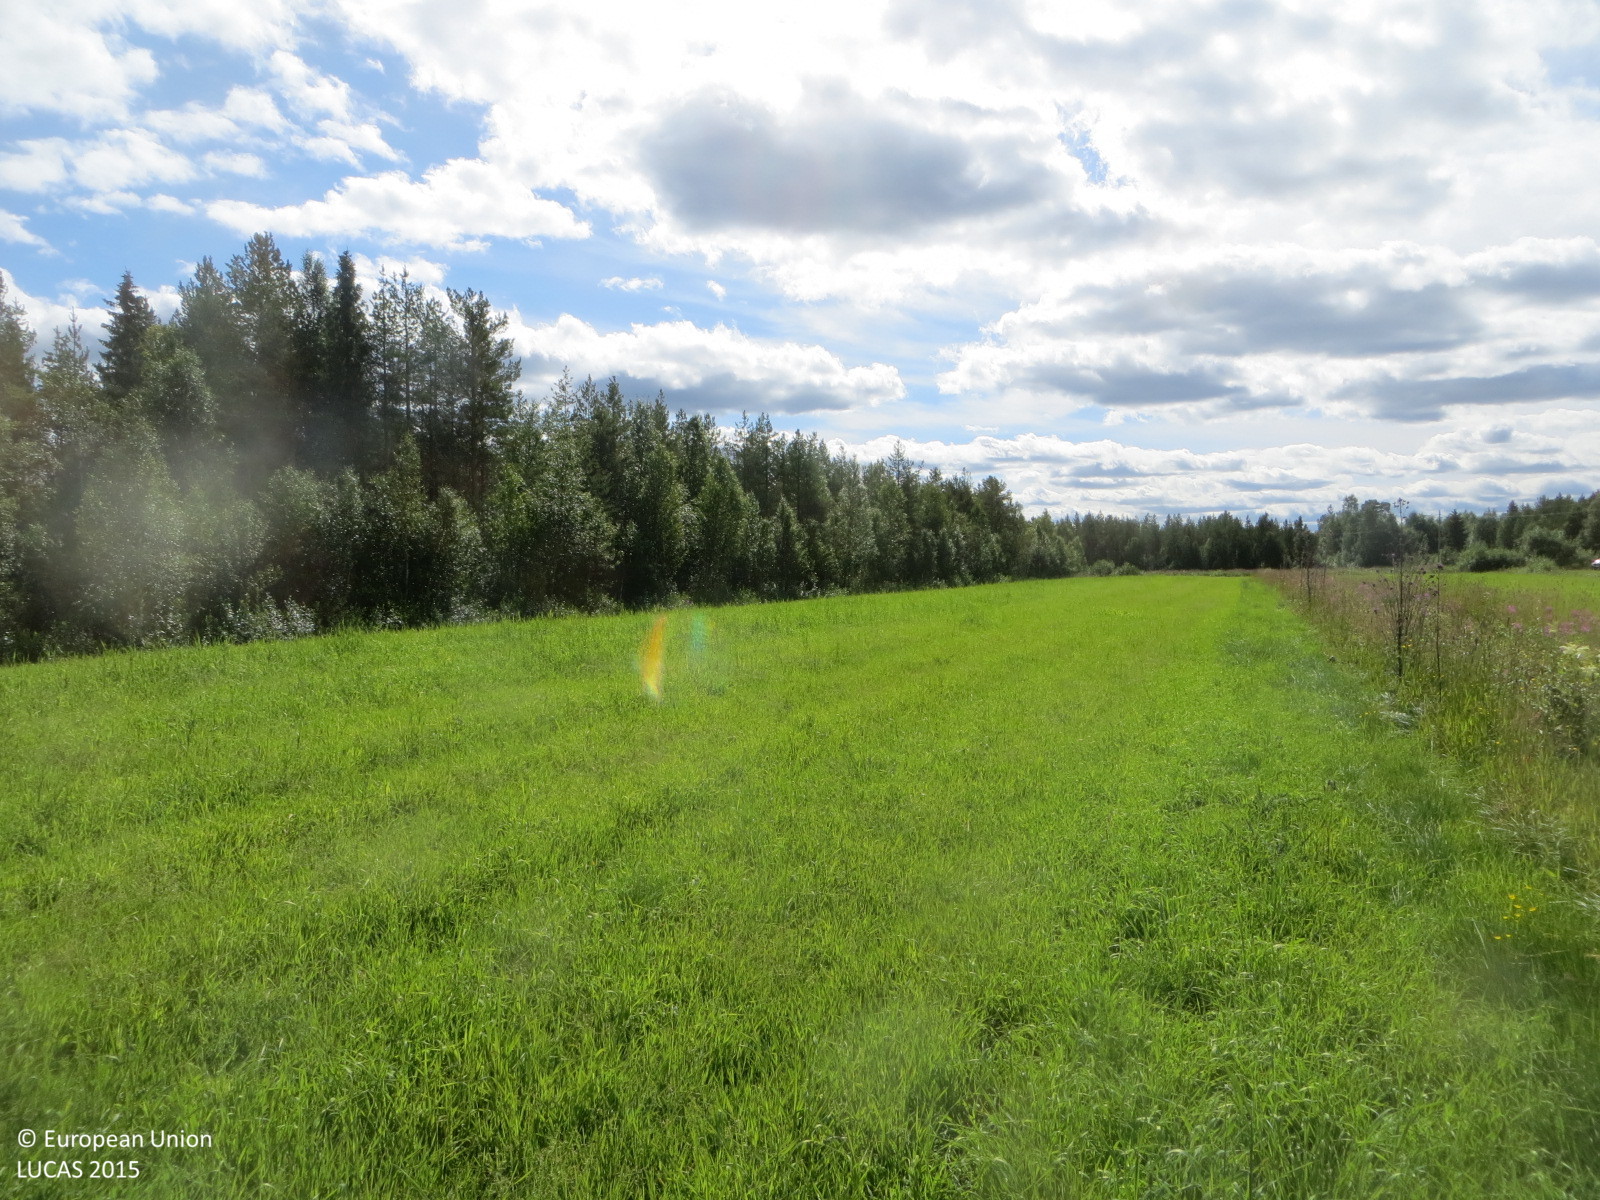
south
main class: Grassland
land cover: Grassland without tree/shrub cover
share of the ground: > 75 %
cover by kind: herbaceous plants 100 %
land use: Agriculture (excluding fallow land and kitchen gardens)
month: August
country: FI
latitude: 66.2291
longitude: 25.6108
